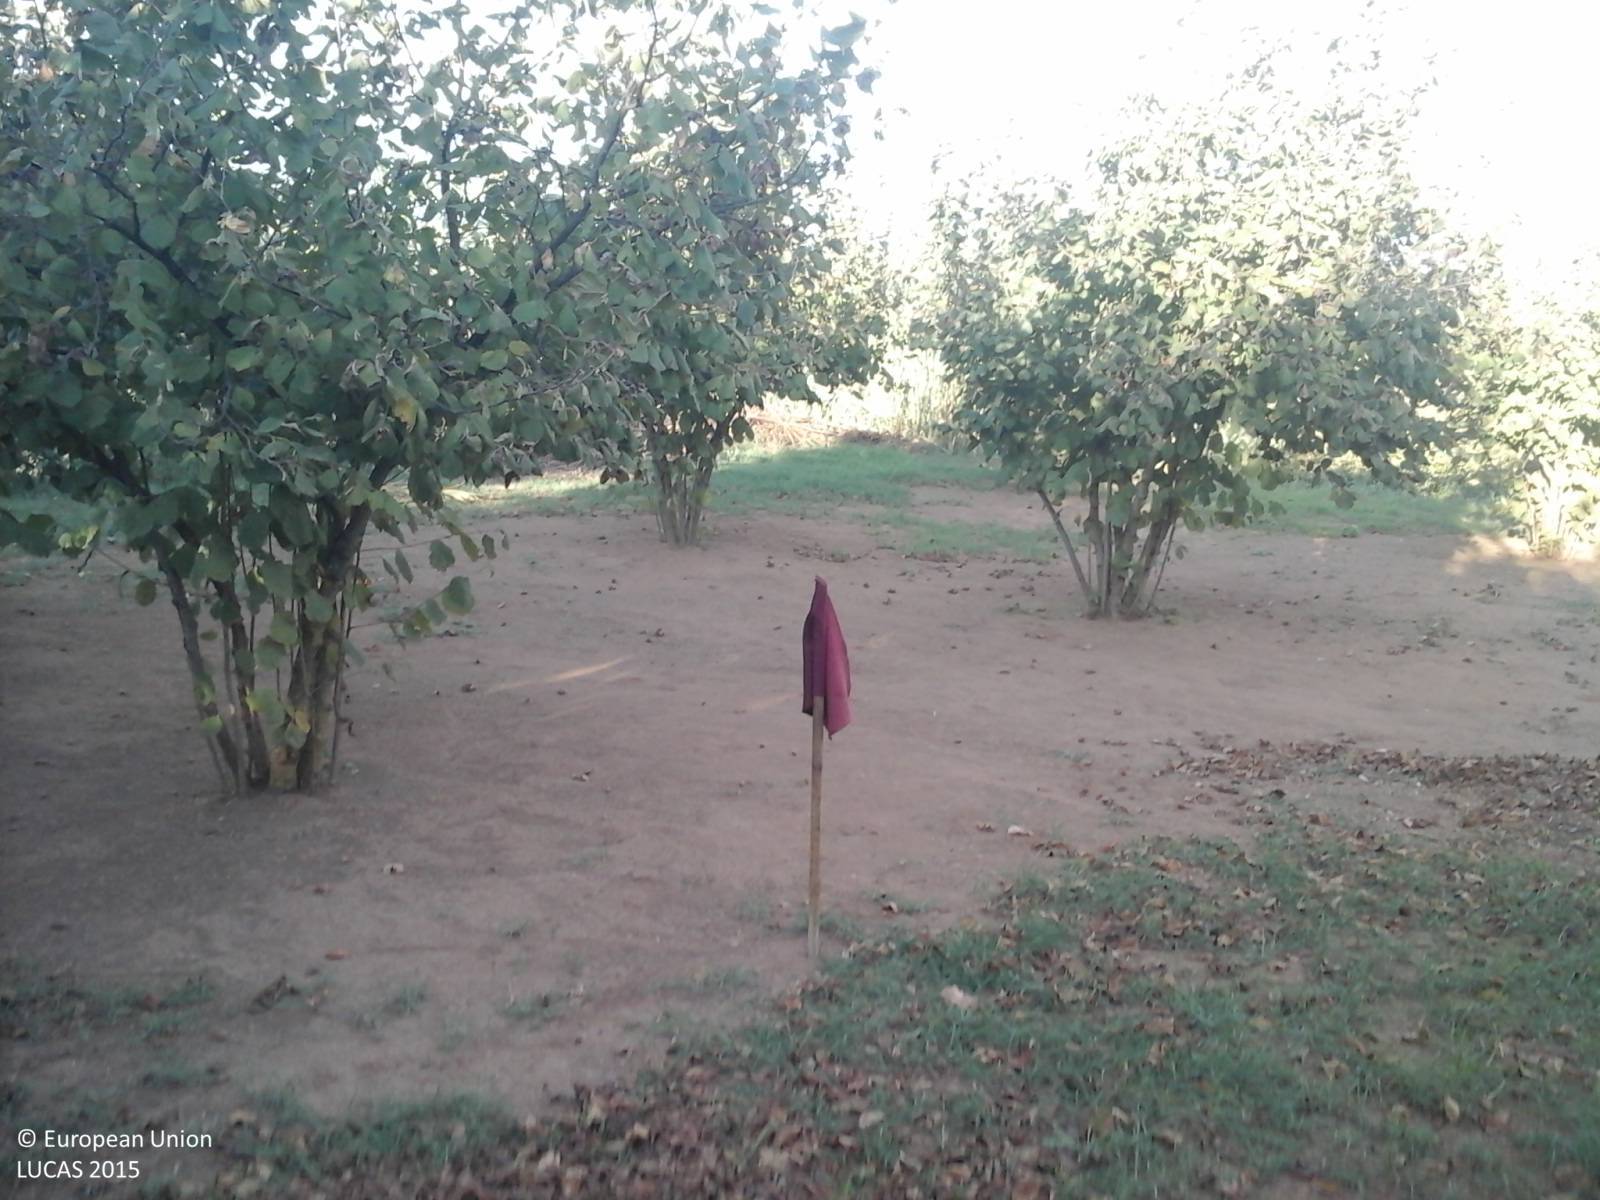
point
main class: Cropland
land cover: Nuts trees
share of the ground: > 75 %
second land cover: Other bare soil
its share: > 75 %
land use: Agriculture (excluding fallow land and kitchen gardens)
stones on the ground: < 10 %
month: September
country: IT
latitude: 42.3927
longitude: 12.3124
